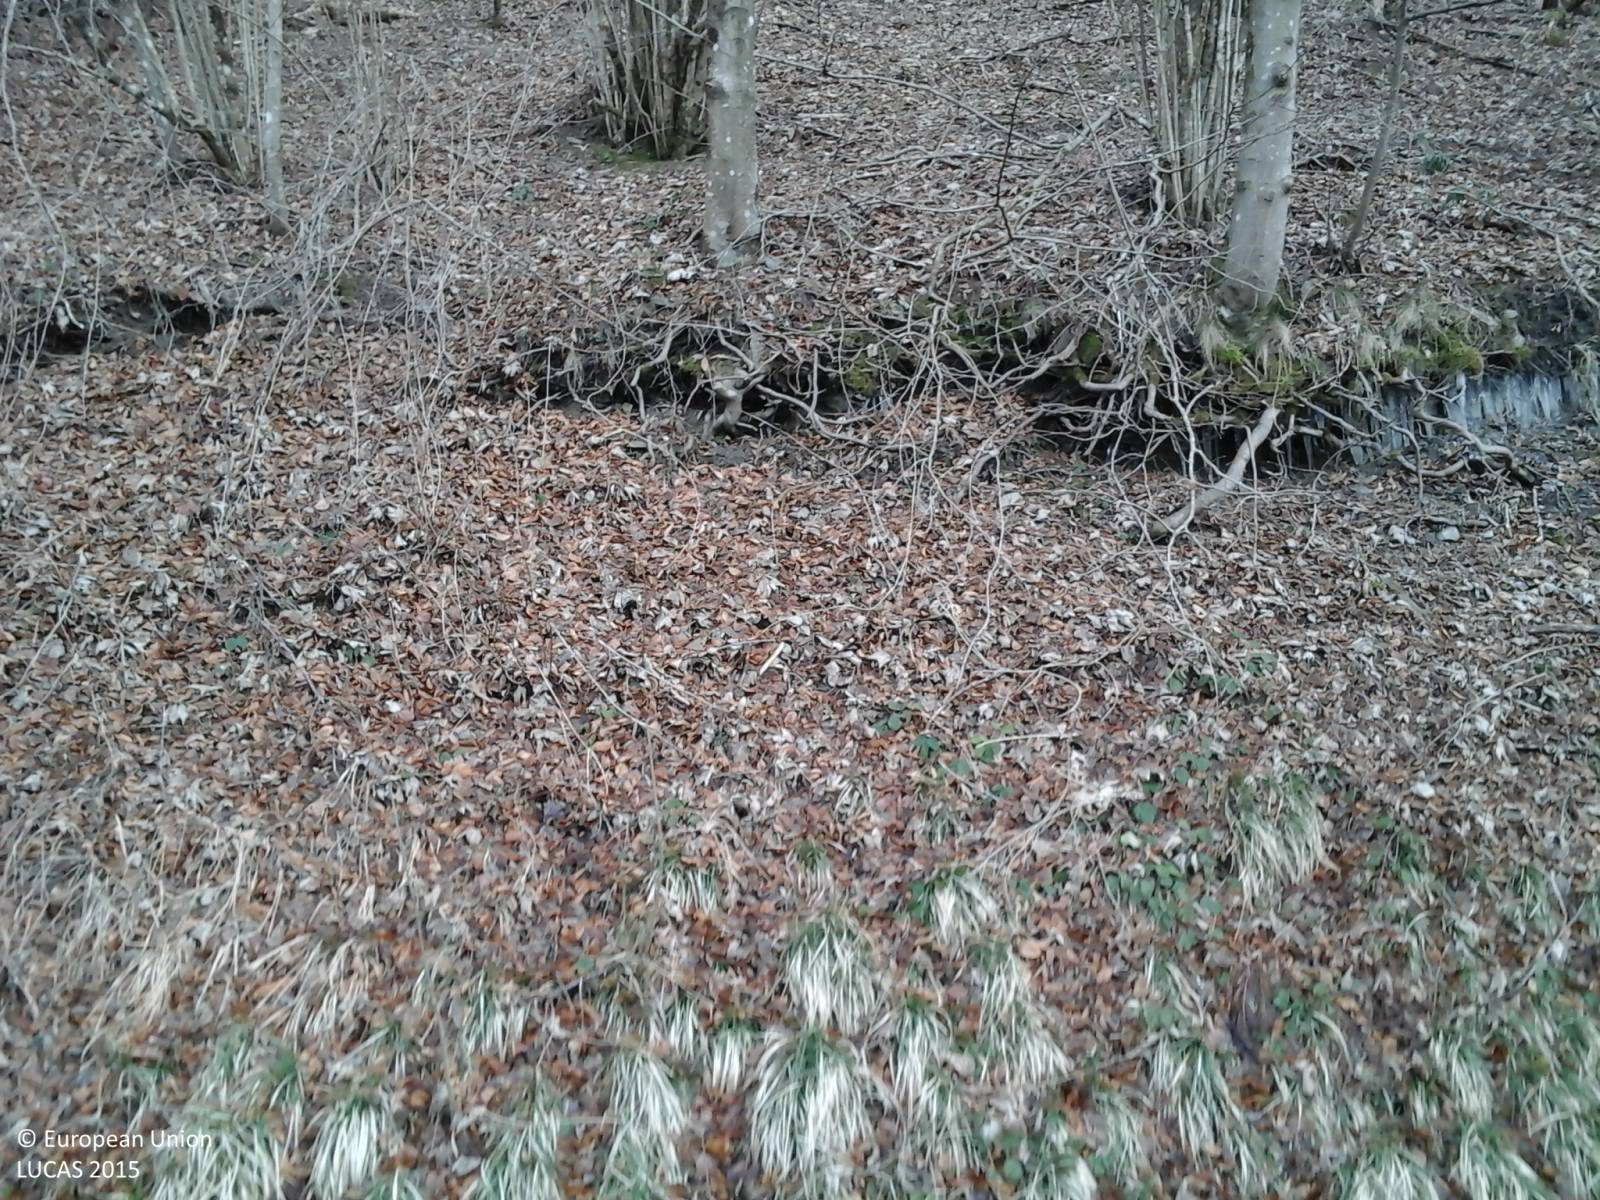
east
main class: Woodland
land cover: Broadleaved woodland
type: mesophytic deciduous forest
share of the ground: > 75 %
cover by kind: broadleaved forest trees 100 %
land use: Forestry
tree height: > 5 m
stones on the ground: 10 - 25 %
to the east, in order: Broadleaved woodland; Paved roads, cycling and walking lanes; Broadleaved woodland
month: January
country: IT
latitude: 44.4916
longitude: 9.1844
